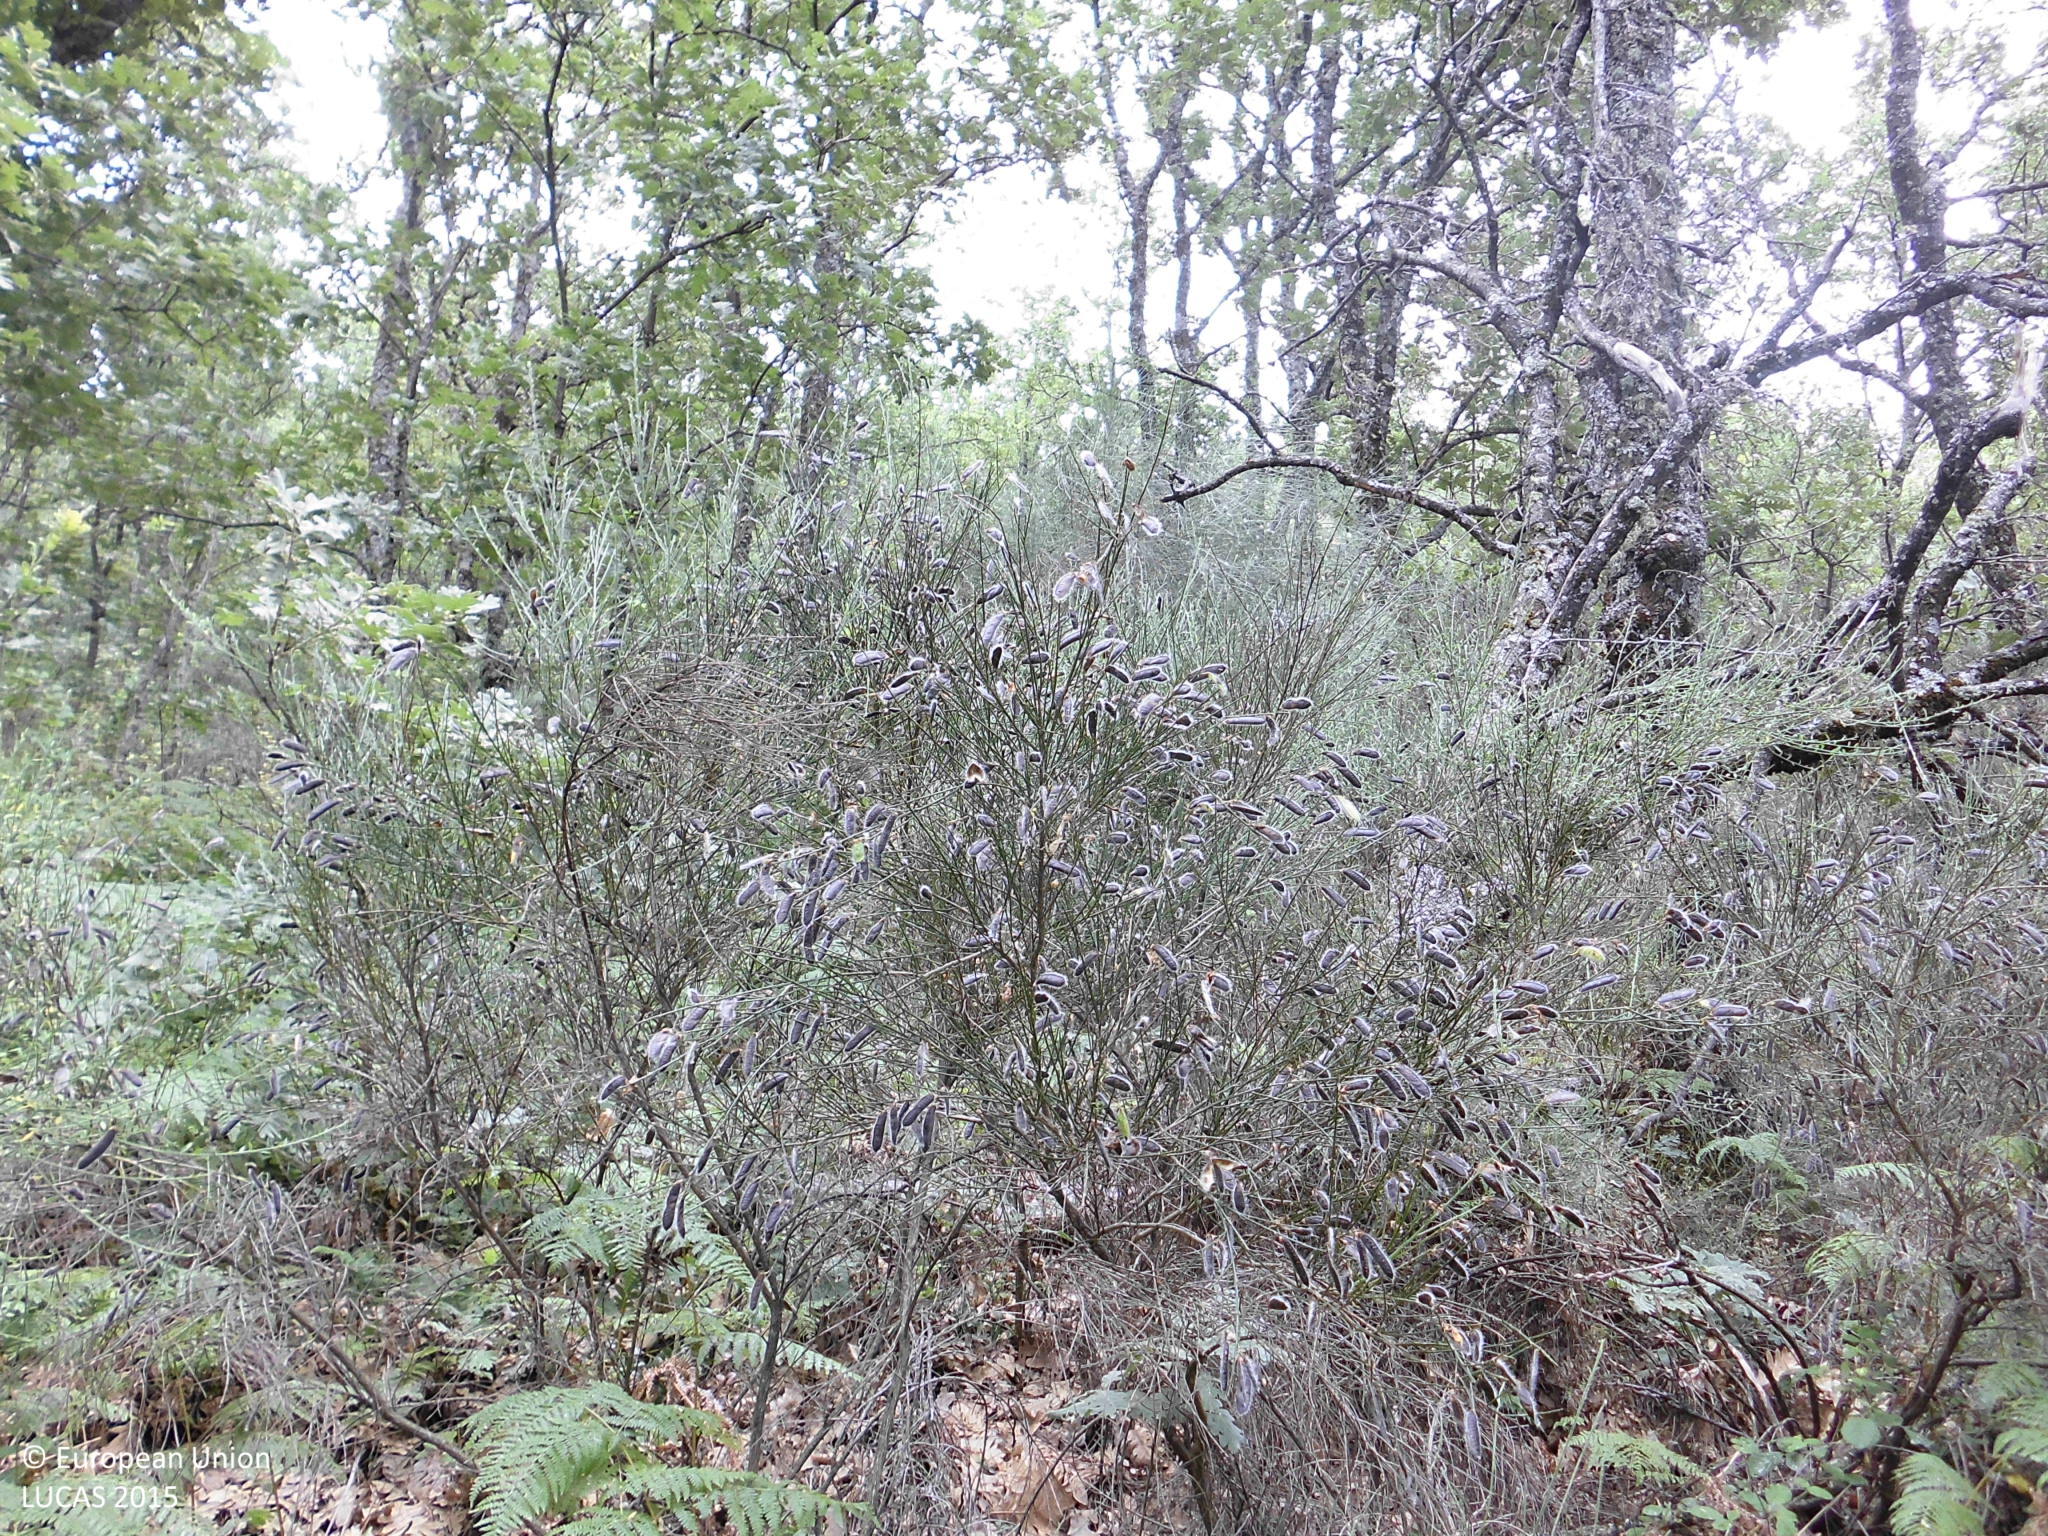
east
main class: Shrubland
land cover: Shrubland with sparse tree cover
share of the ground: > 75 %
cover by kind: shrubs 90 %, broadleaved forest trees 5 %, herbaceous plants 5 %
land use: Agriculture (excluding fallow land and kitchen gardens)
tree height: > 5 m
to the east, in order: Shrubland with sparse tree cover; Pine dominated coniferous woodland
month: June
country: ES
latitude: 40.0575
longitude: -5.8345
